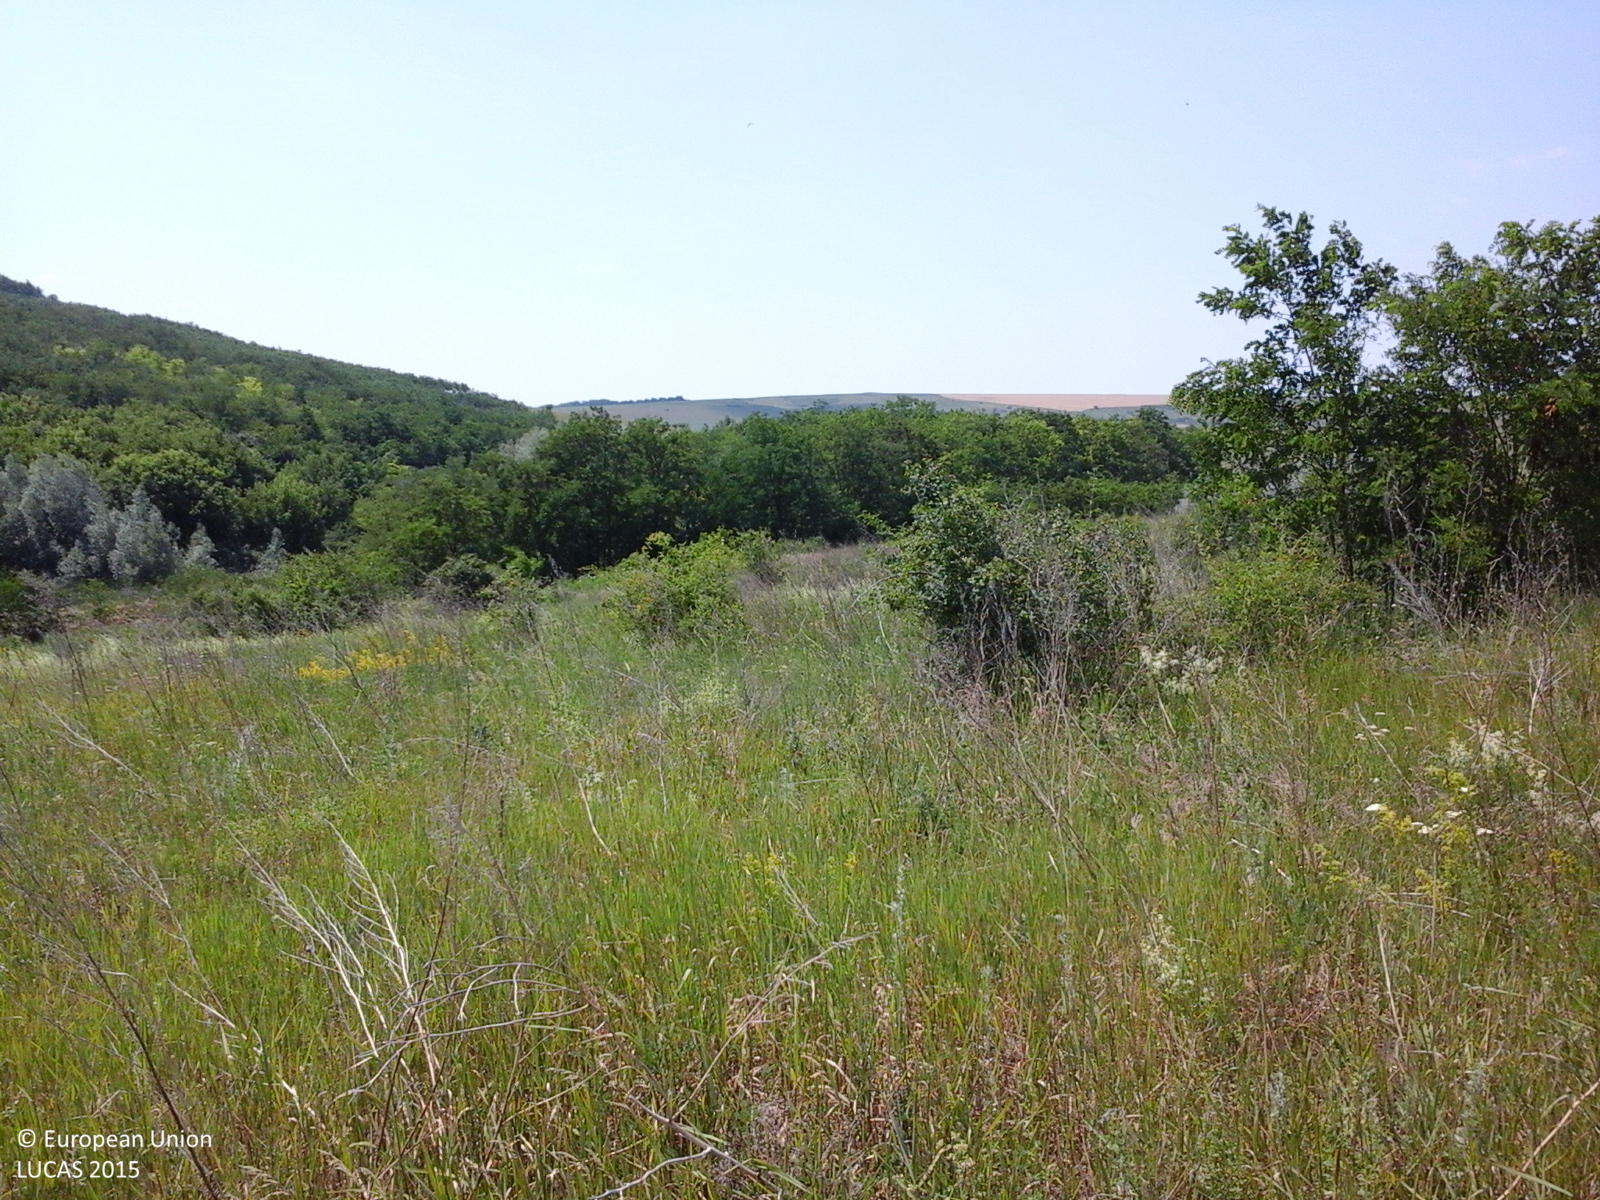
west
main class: Grassland
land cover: Grassland with sparse tree/shrub cover
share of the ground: > 75 %
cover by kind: herbaceous plants 90 %, broadleaved forest trees 5 %, shrubs 5 %
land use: Agriculture (excluding fallow land and kitchen gardens)
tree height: < 5 m
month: June
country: RO
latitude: 47.2441
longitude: 27.6526
